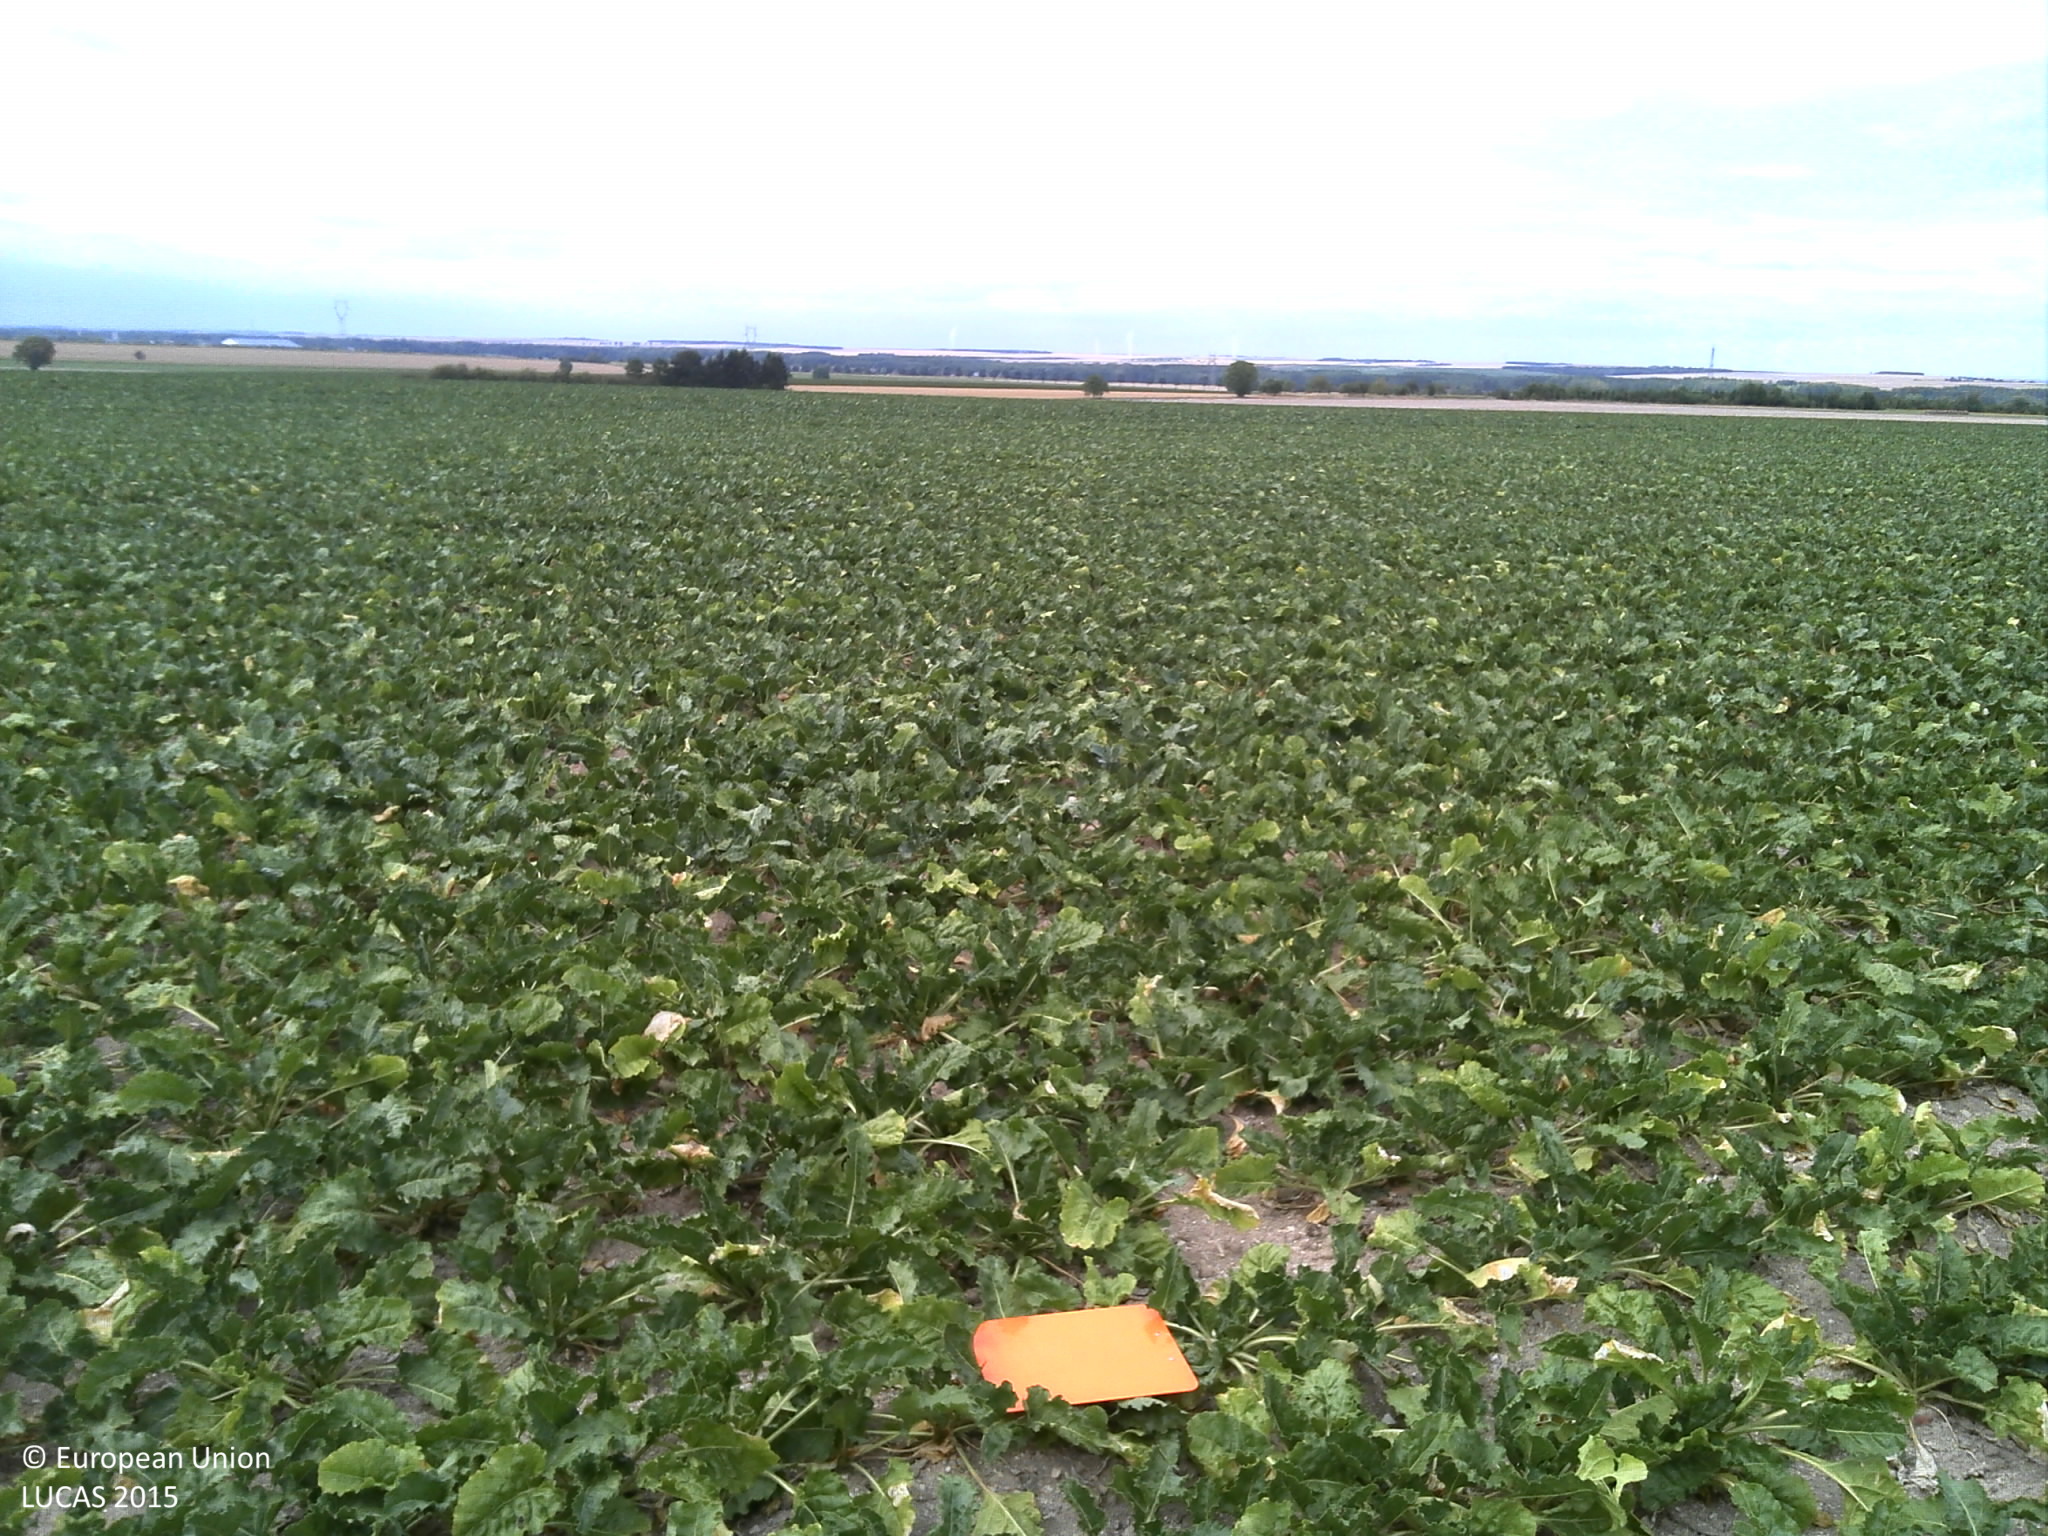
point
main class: Cropland
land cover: Sugar beet
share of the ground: 50 - 75 %
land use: Agriculture (excluding fallow land and kitchen gardens)
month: August
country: FR
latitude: 48.5047
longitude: 4.2170
